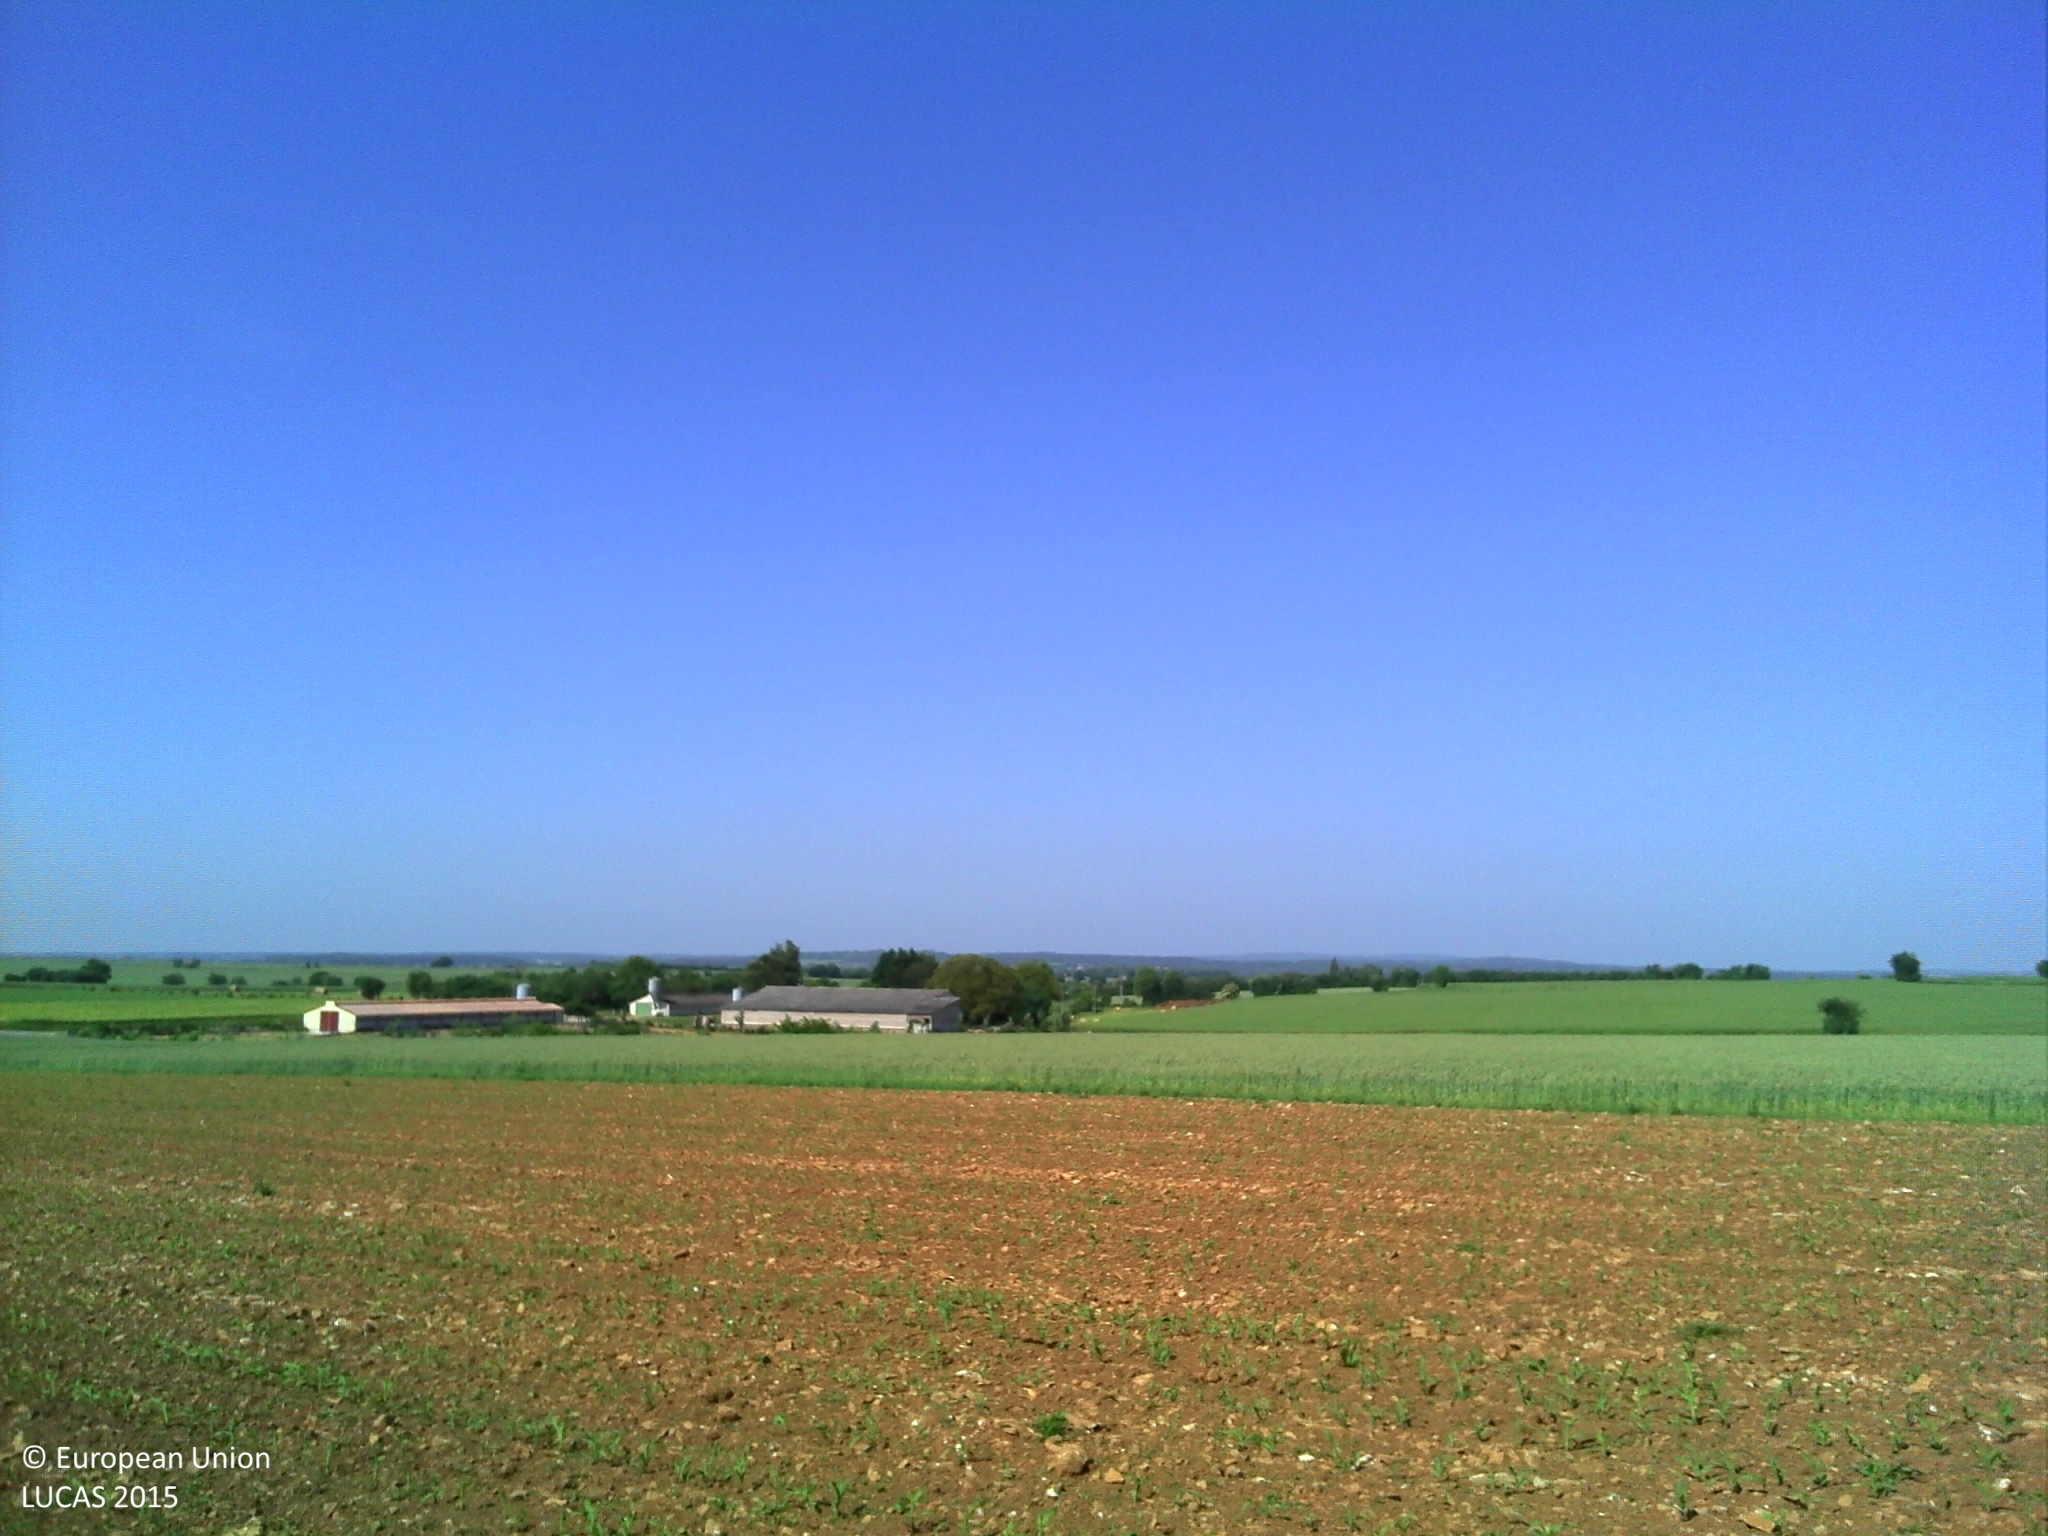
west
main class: Cropland
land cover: Maize
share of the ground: < 10 %
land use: Agriculture (excluding fallow land and kitchen gardens)
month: June
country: FR
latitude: 48.1115
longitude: -0.0080
